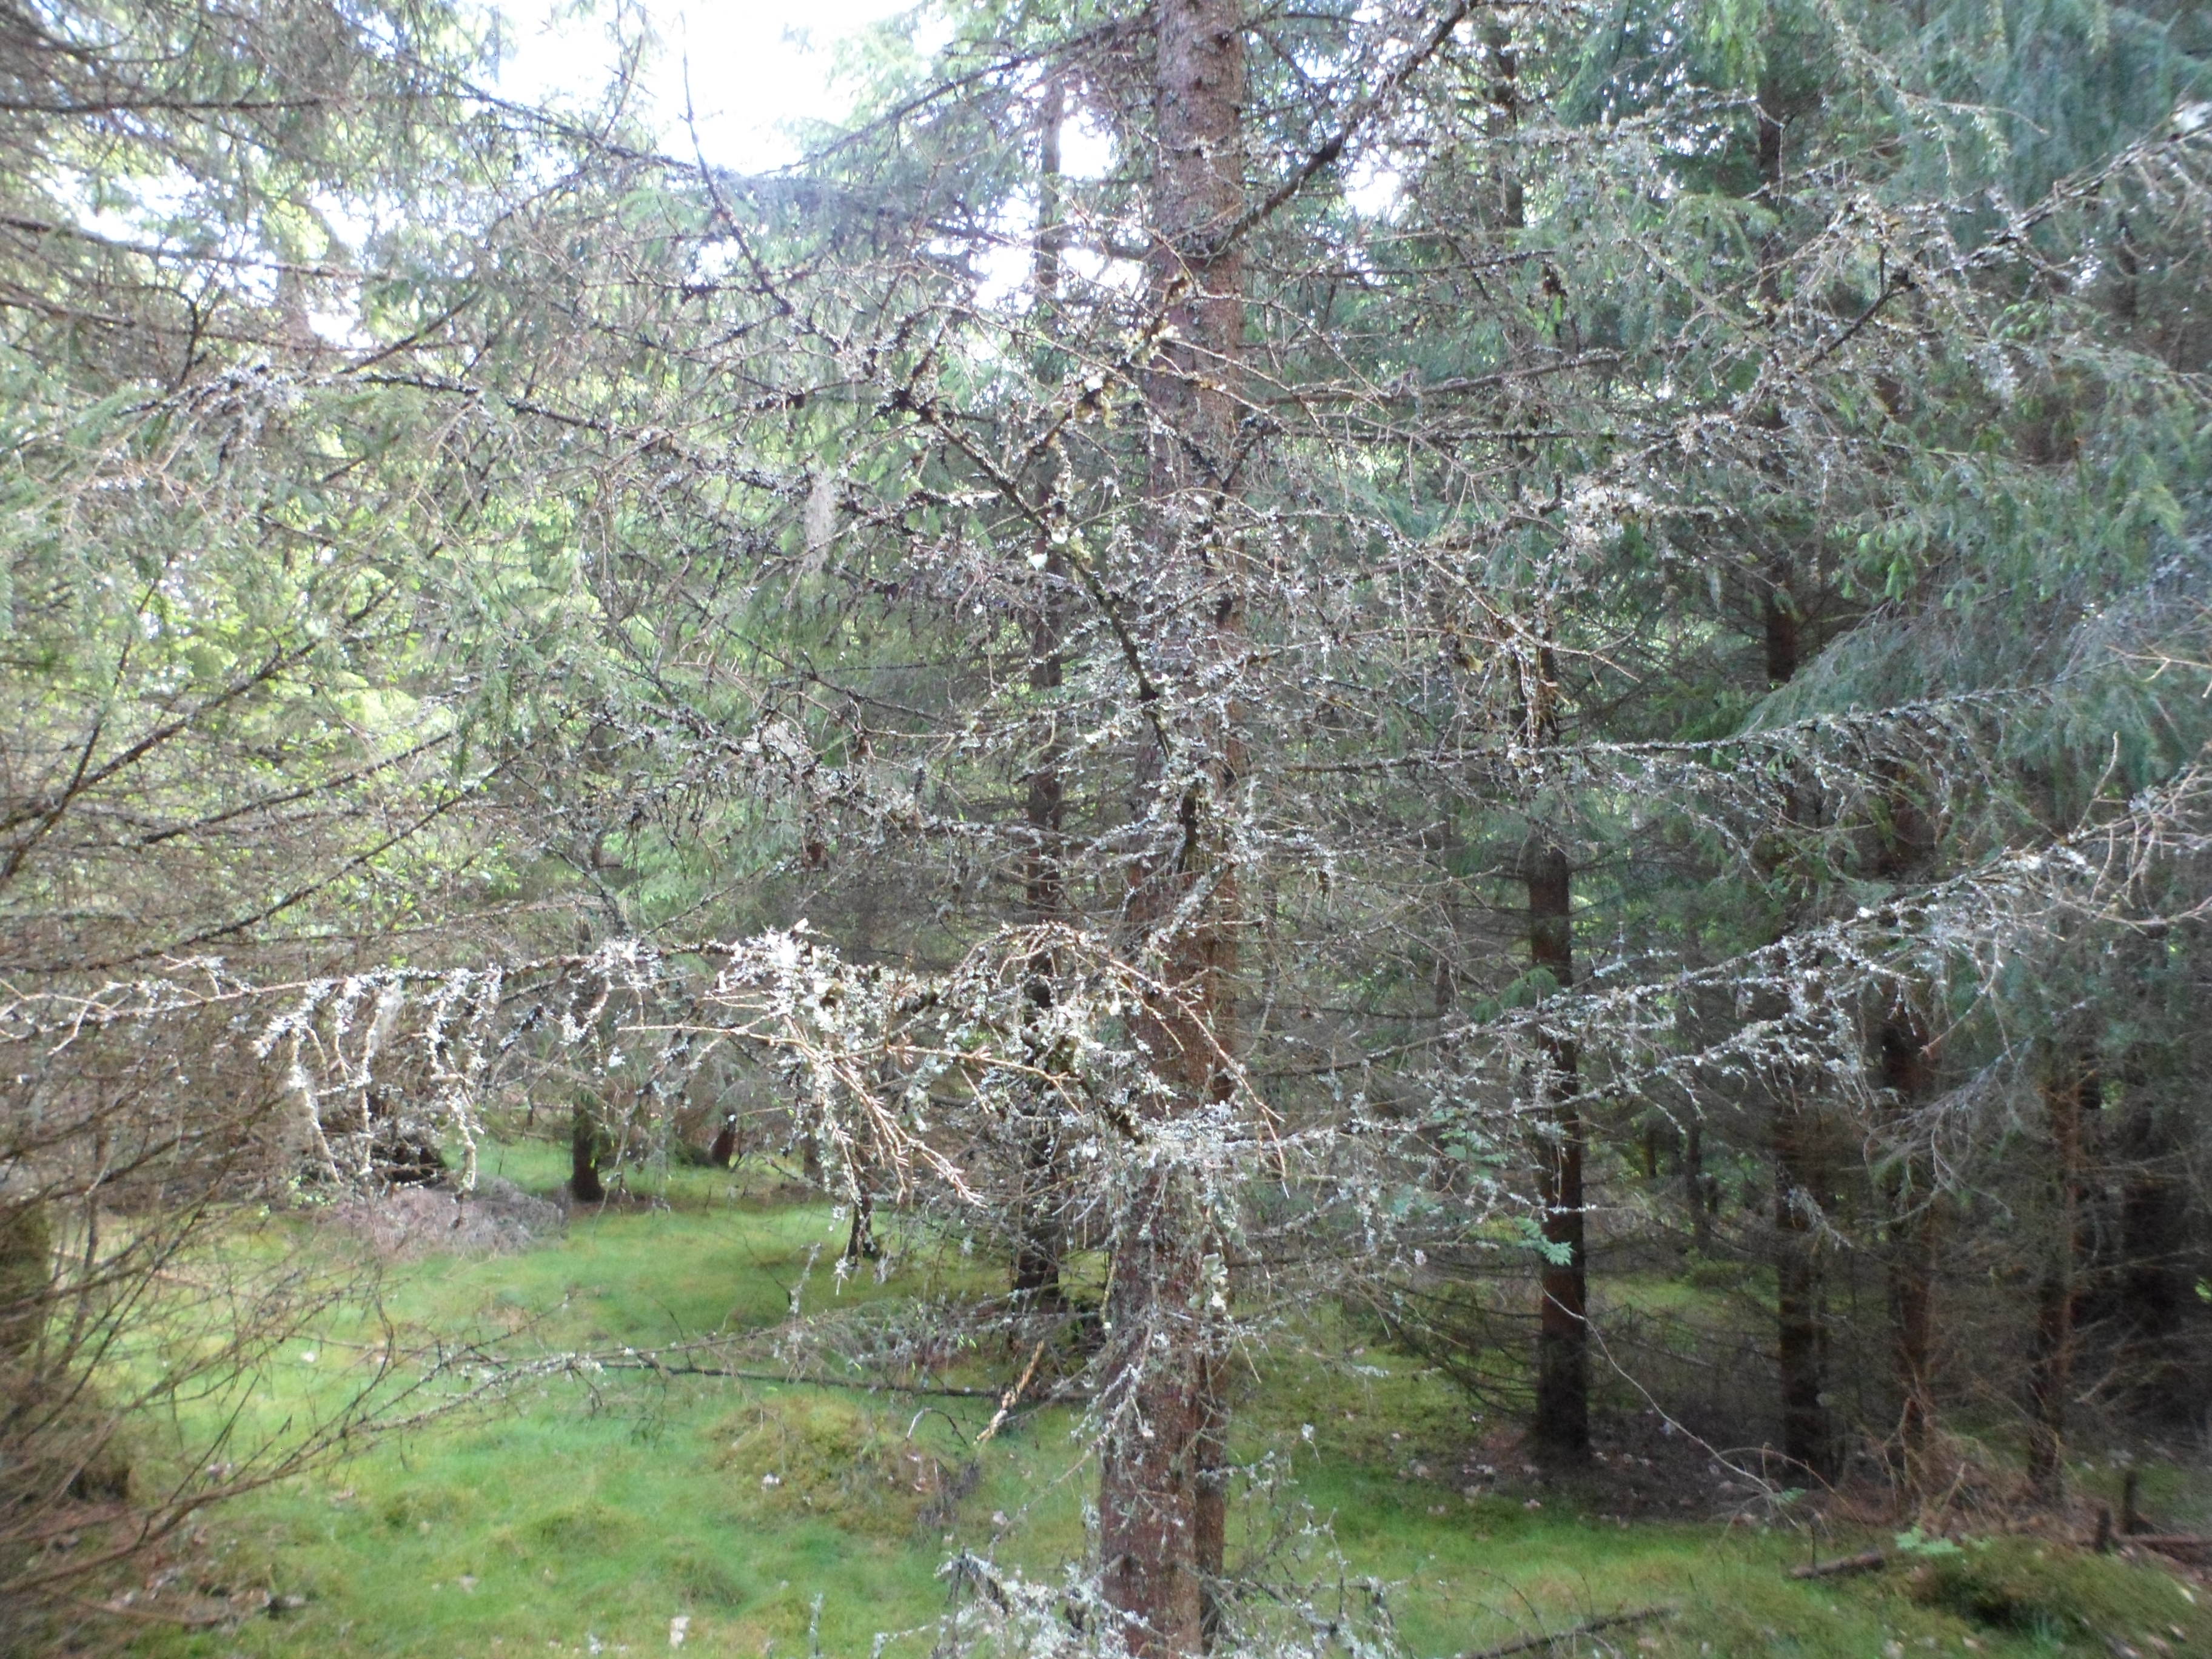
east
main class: Woodland
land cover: Spruce dominated coniferous woodland
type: boreal forest
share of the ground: 50 - 75 %
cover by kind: coniferous forest trees 50 %, lichens and mosses 25 %, broadleaved forest trees 10 %, shrubs 10 %, herbaceous plants 5 %
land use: Forestry
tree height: > 5 m
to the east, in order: Spruce dominated coniferous woodland; Spruce dominated mixed woodland; Dry stone walls; Broadleaved woodland; Fences; Broadleaved woodland; Grassland with sparse tree/shrub cover; Broadleaved woodland; Fences; Broadleaved woodland; Grassland with sparse tree/shrub cover
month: June
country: SE
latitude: 56.9423
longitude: 14.3525
